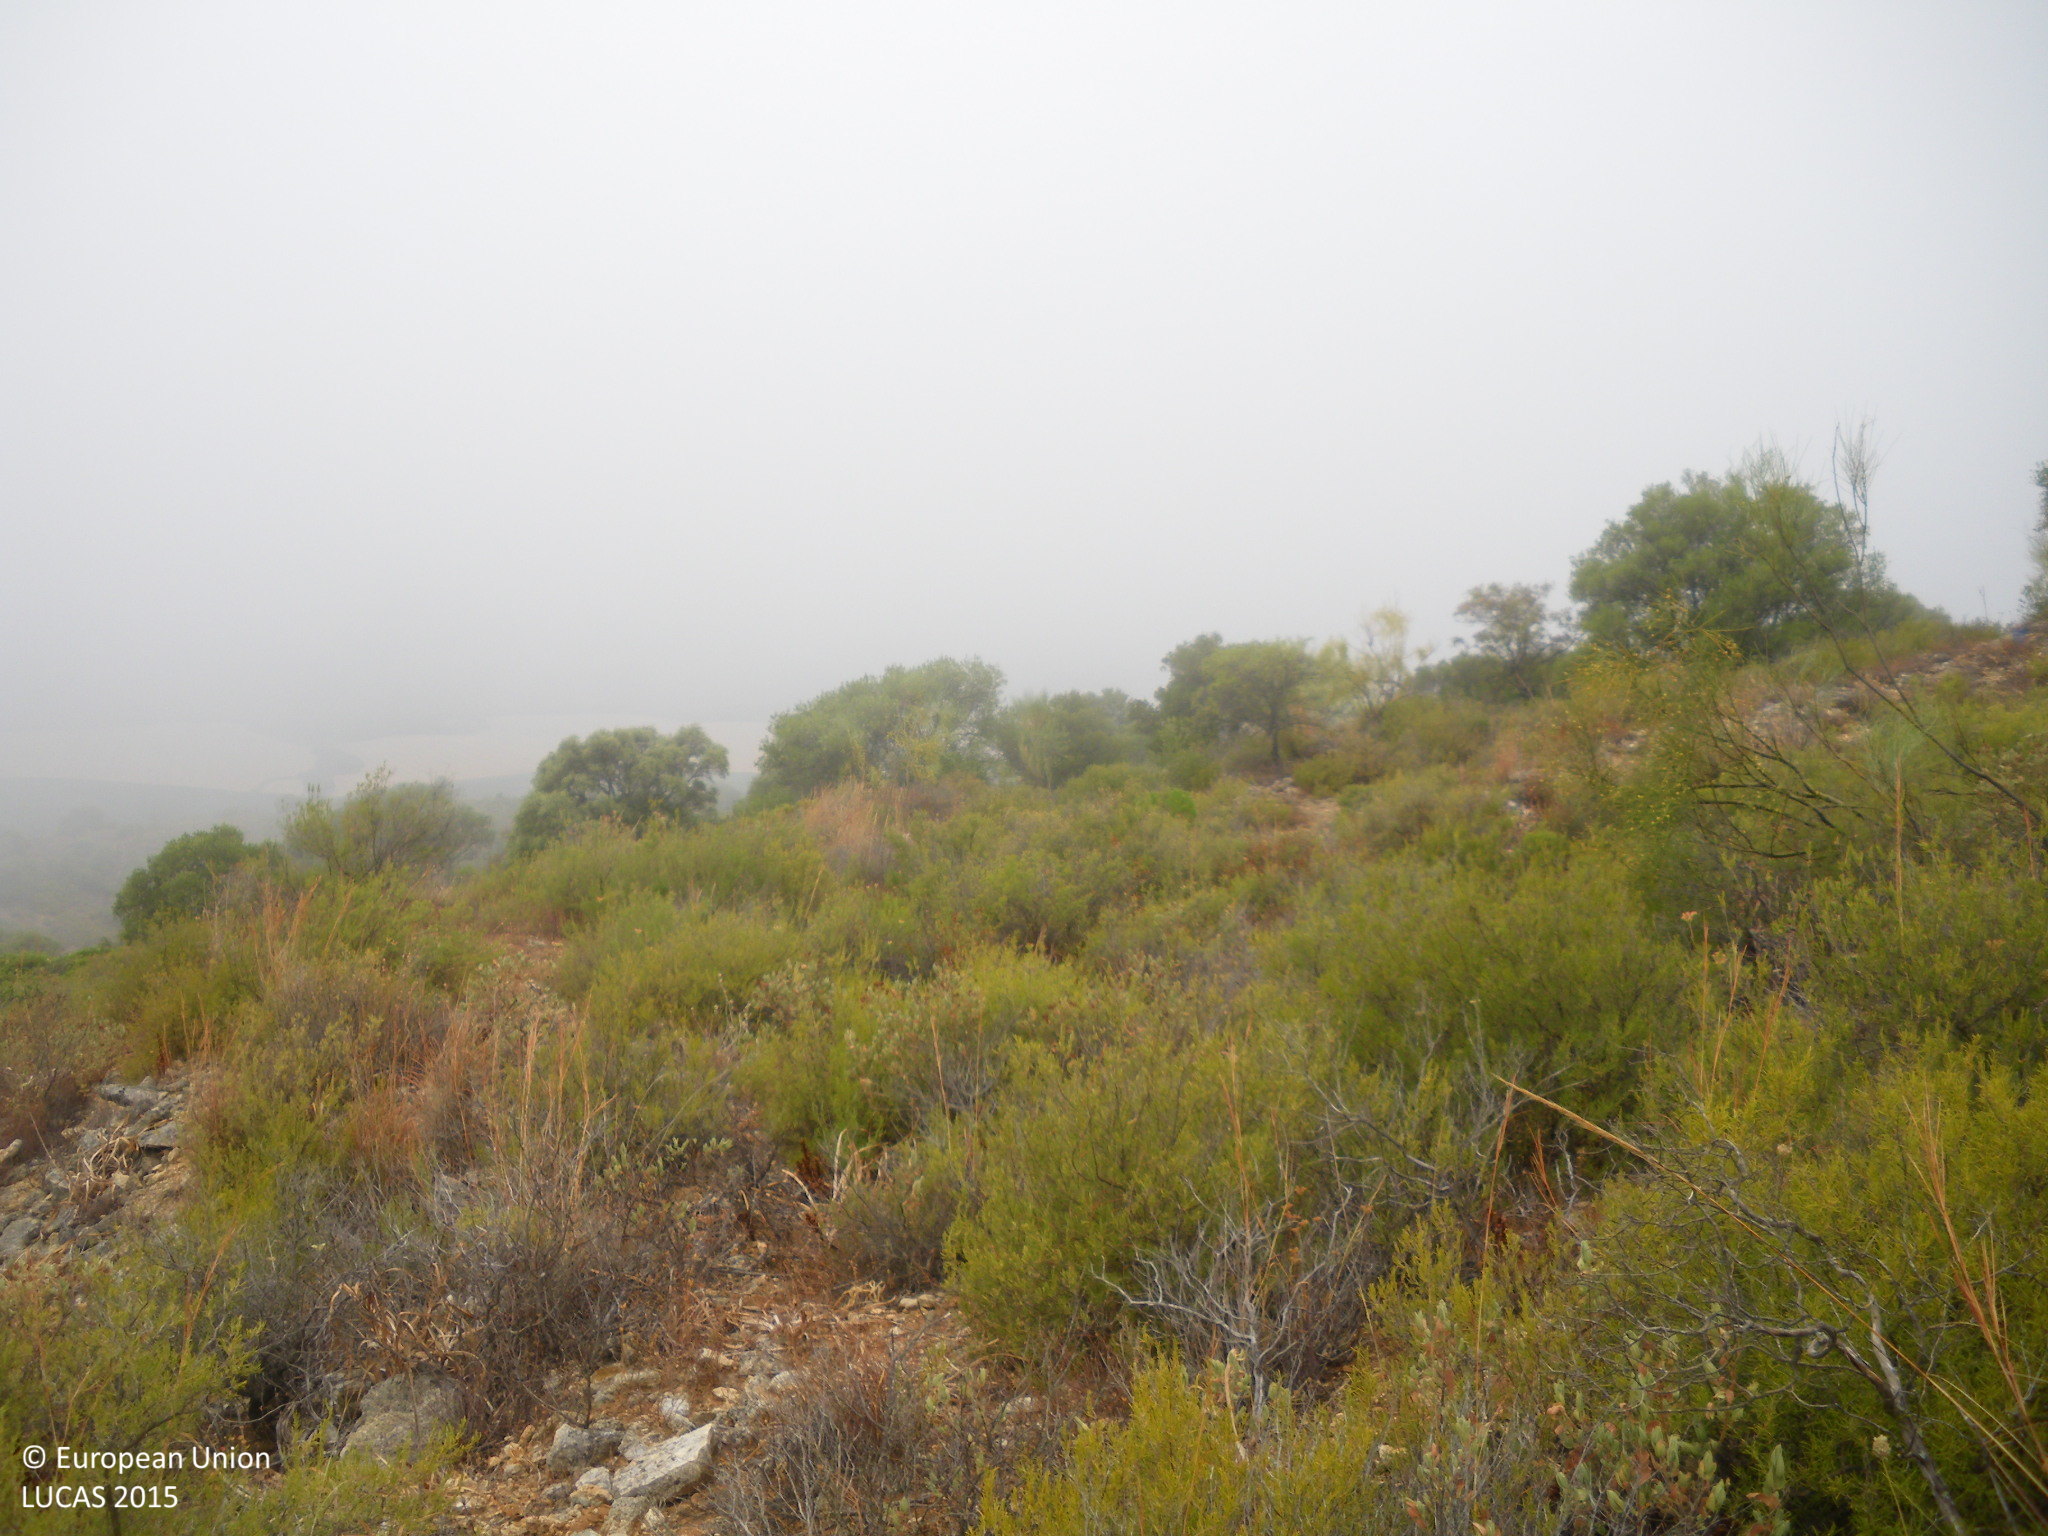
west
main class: Shrubland
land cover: Shrubland with sparse tree cover
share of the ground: > 75 %
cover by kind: shrubs 70 %, unconsolidated bare surface 15 %, herbaceous plants 10 %, broadleaved forest trees 5 %
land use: Semi-natural and natural areas not in use
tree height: < 5 m
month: July
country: ES
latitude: 36.7764
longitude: -5.7501
